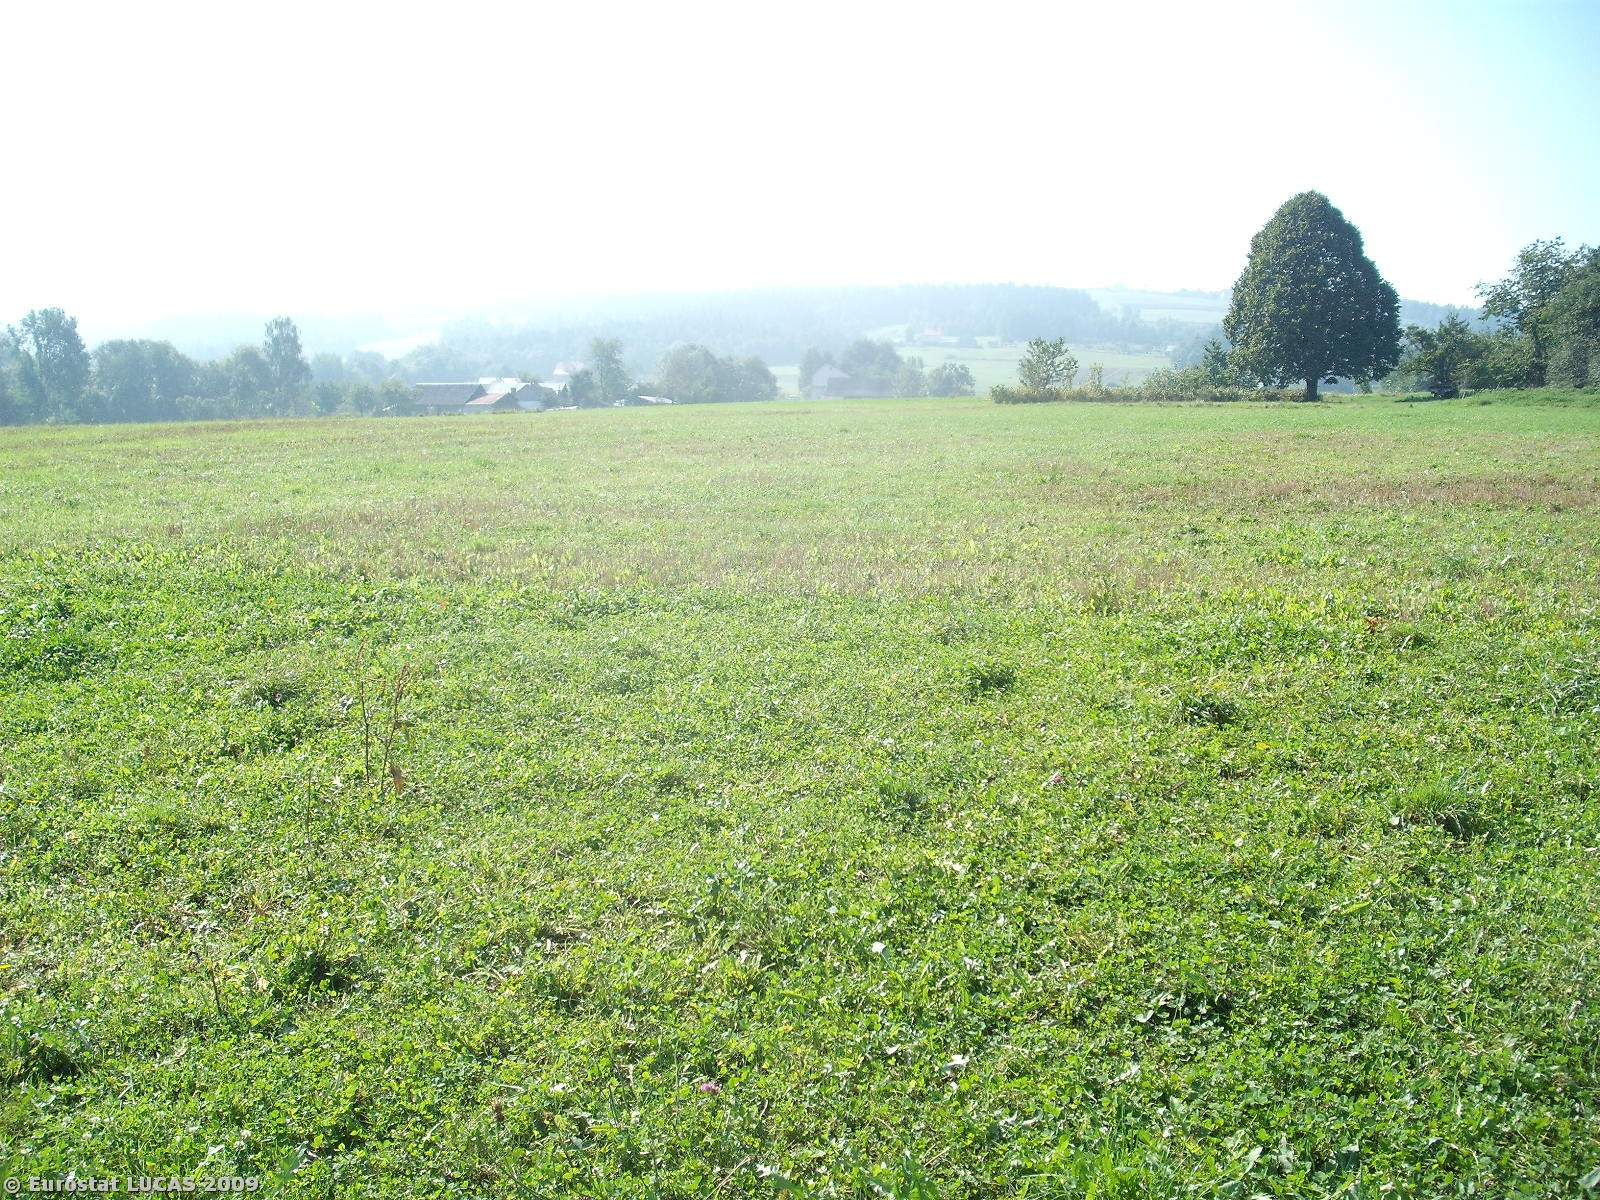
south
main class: Cropland
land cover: Clovers
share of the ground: > 75 %
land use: Agriculture (excluding fallow land and kitchen gardens)
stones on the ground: < 10 %
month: September
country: PL
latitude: 49.6772
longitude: 20.5282
